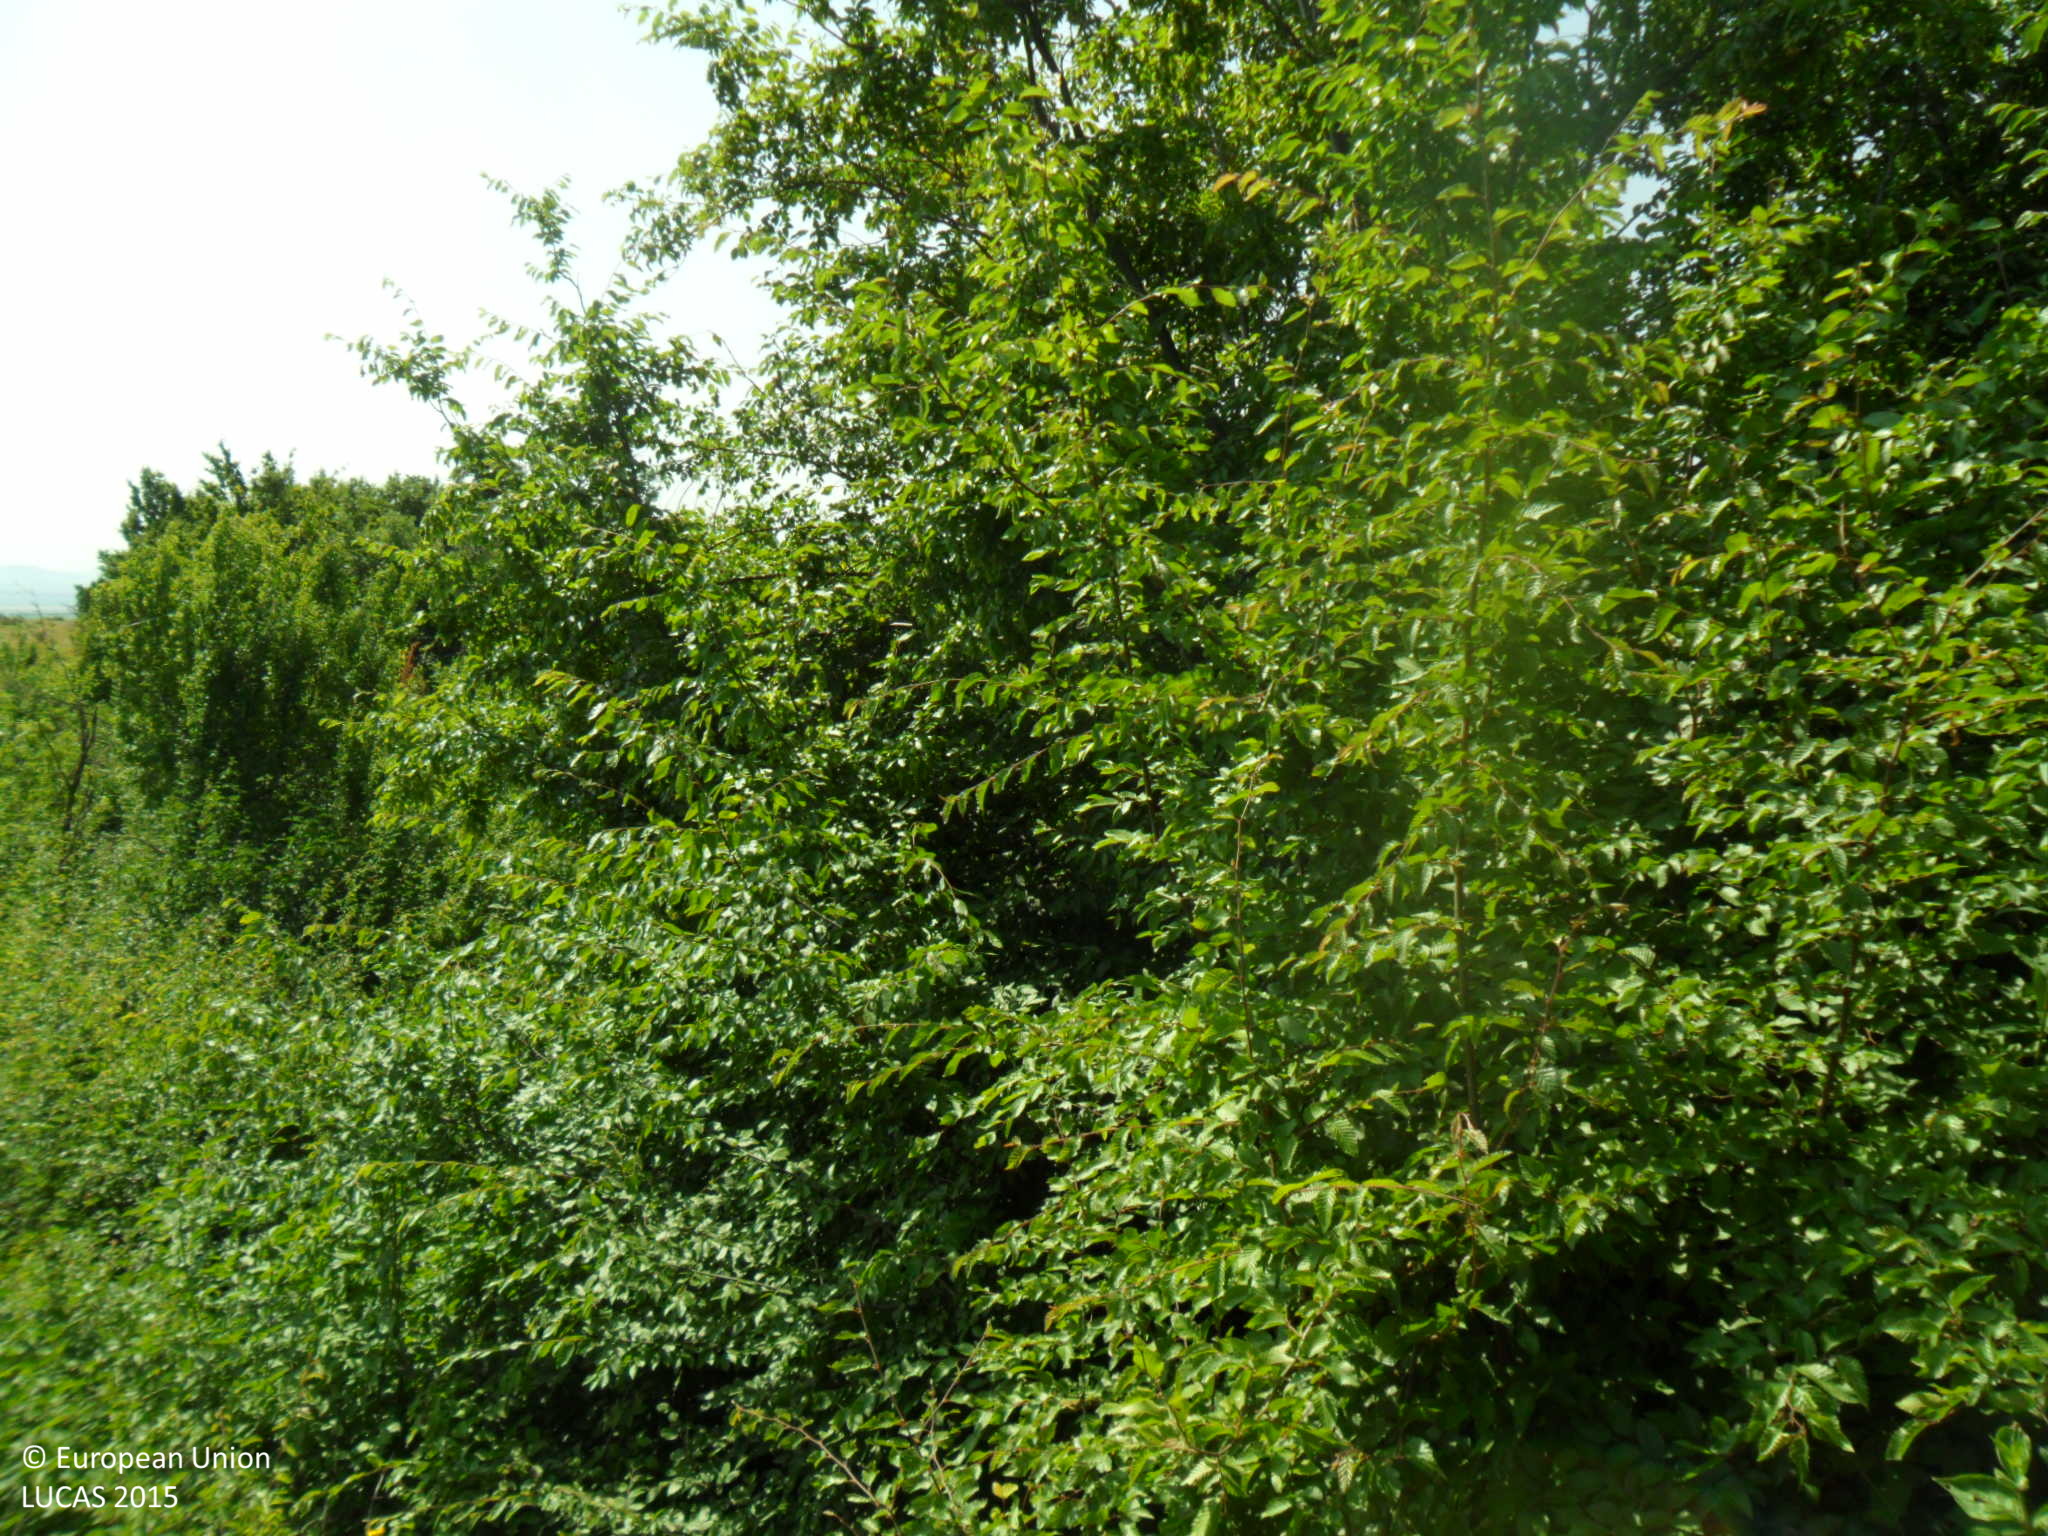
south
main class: Woodland
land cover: Broadleaved woodland
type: mesophytic deciduous forest
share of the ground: > 75 %
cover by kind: broadleaved forest trees 95 %, shrubs 5 %
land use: Forestry
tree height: > 5 m
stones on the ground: 10 - 25 %
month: June
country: BG
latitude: 43.4408
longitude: 27.0575
